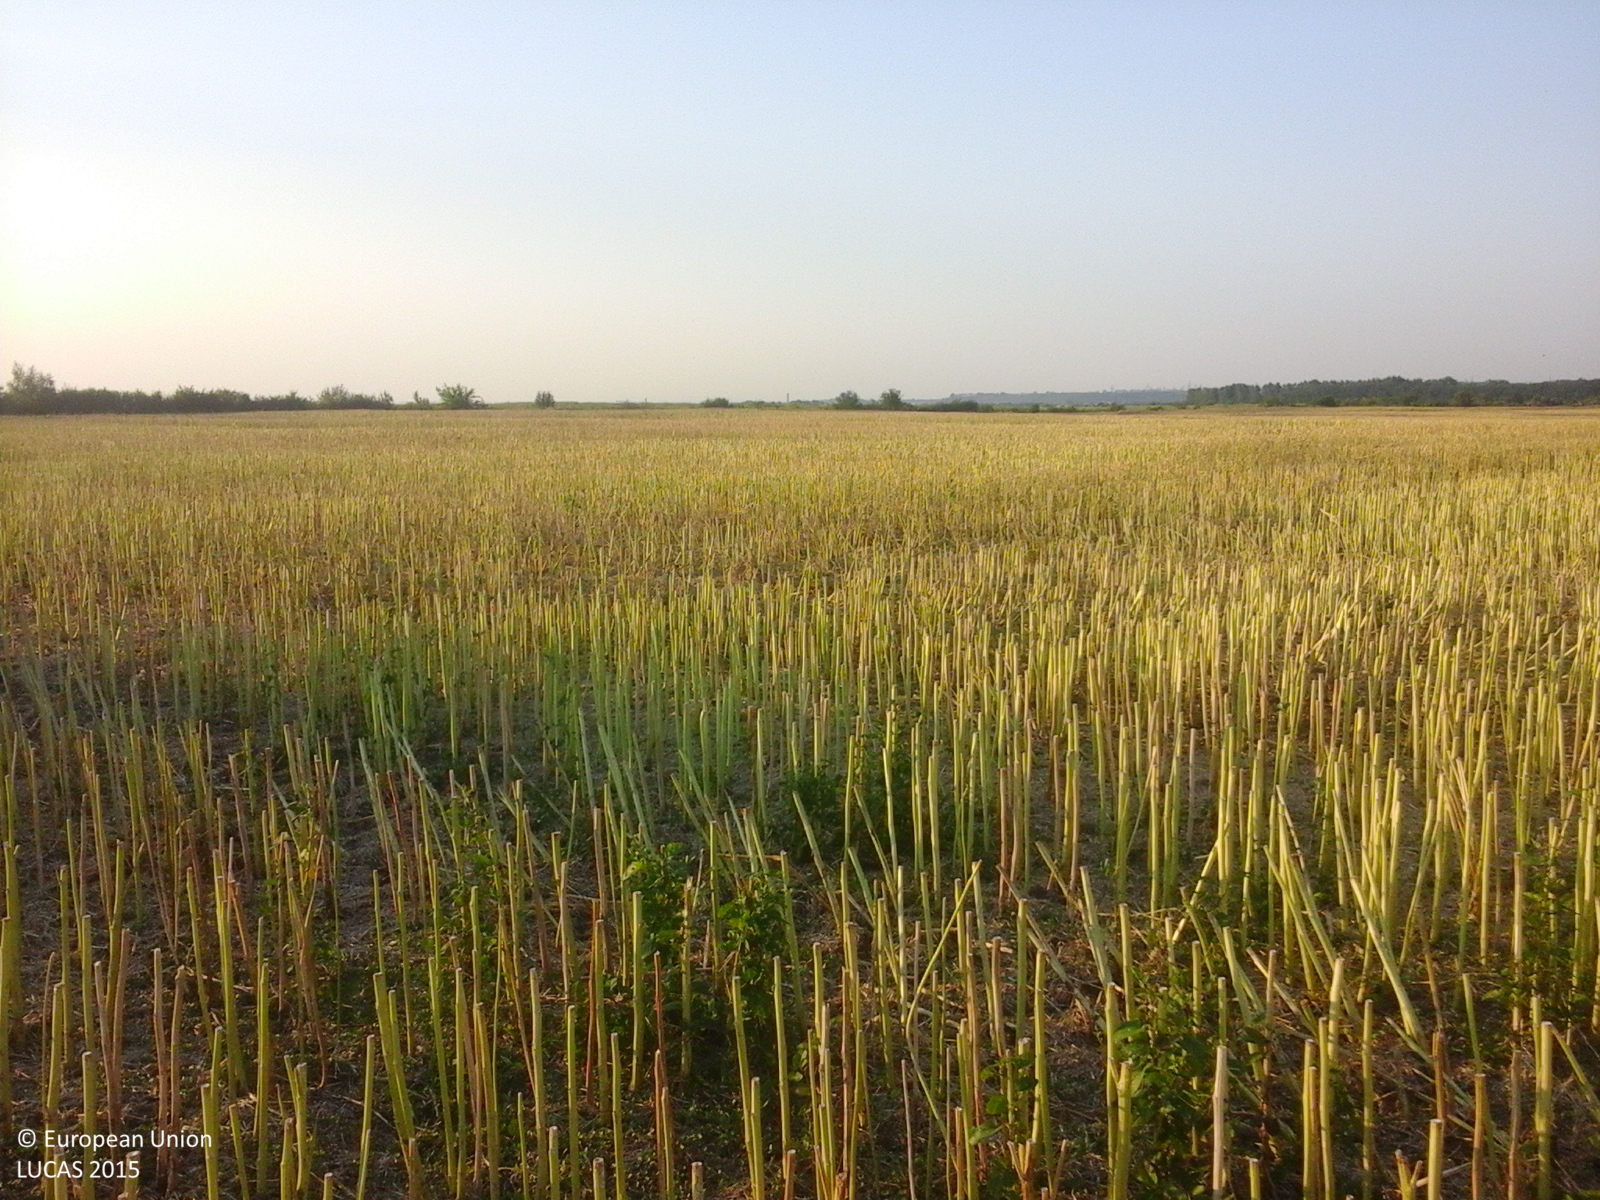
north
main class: Cropland
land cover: Rape and turnip rape
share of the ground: < 10 %
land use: Agriculture (excluding fallow land and kitchen gardens)
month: July
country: RO
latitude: 44.3559
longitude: 24.3315
